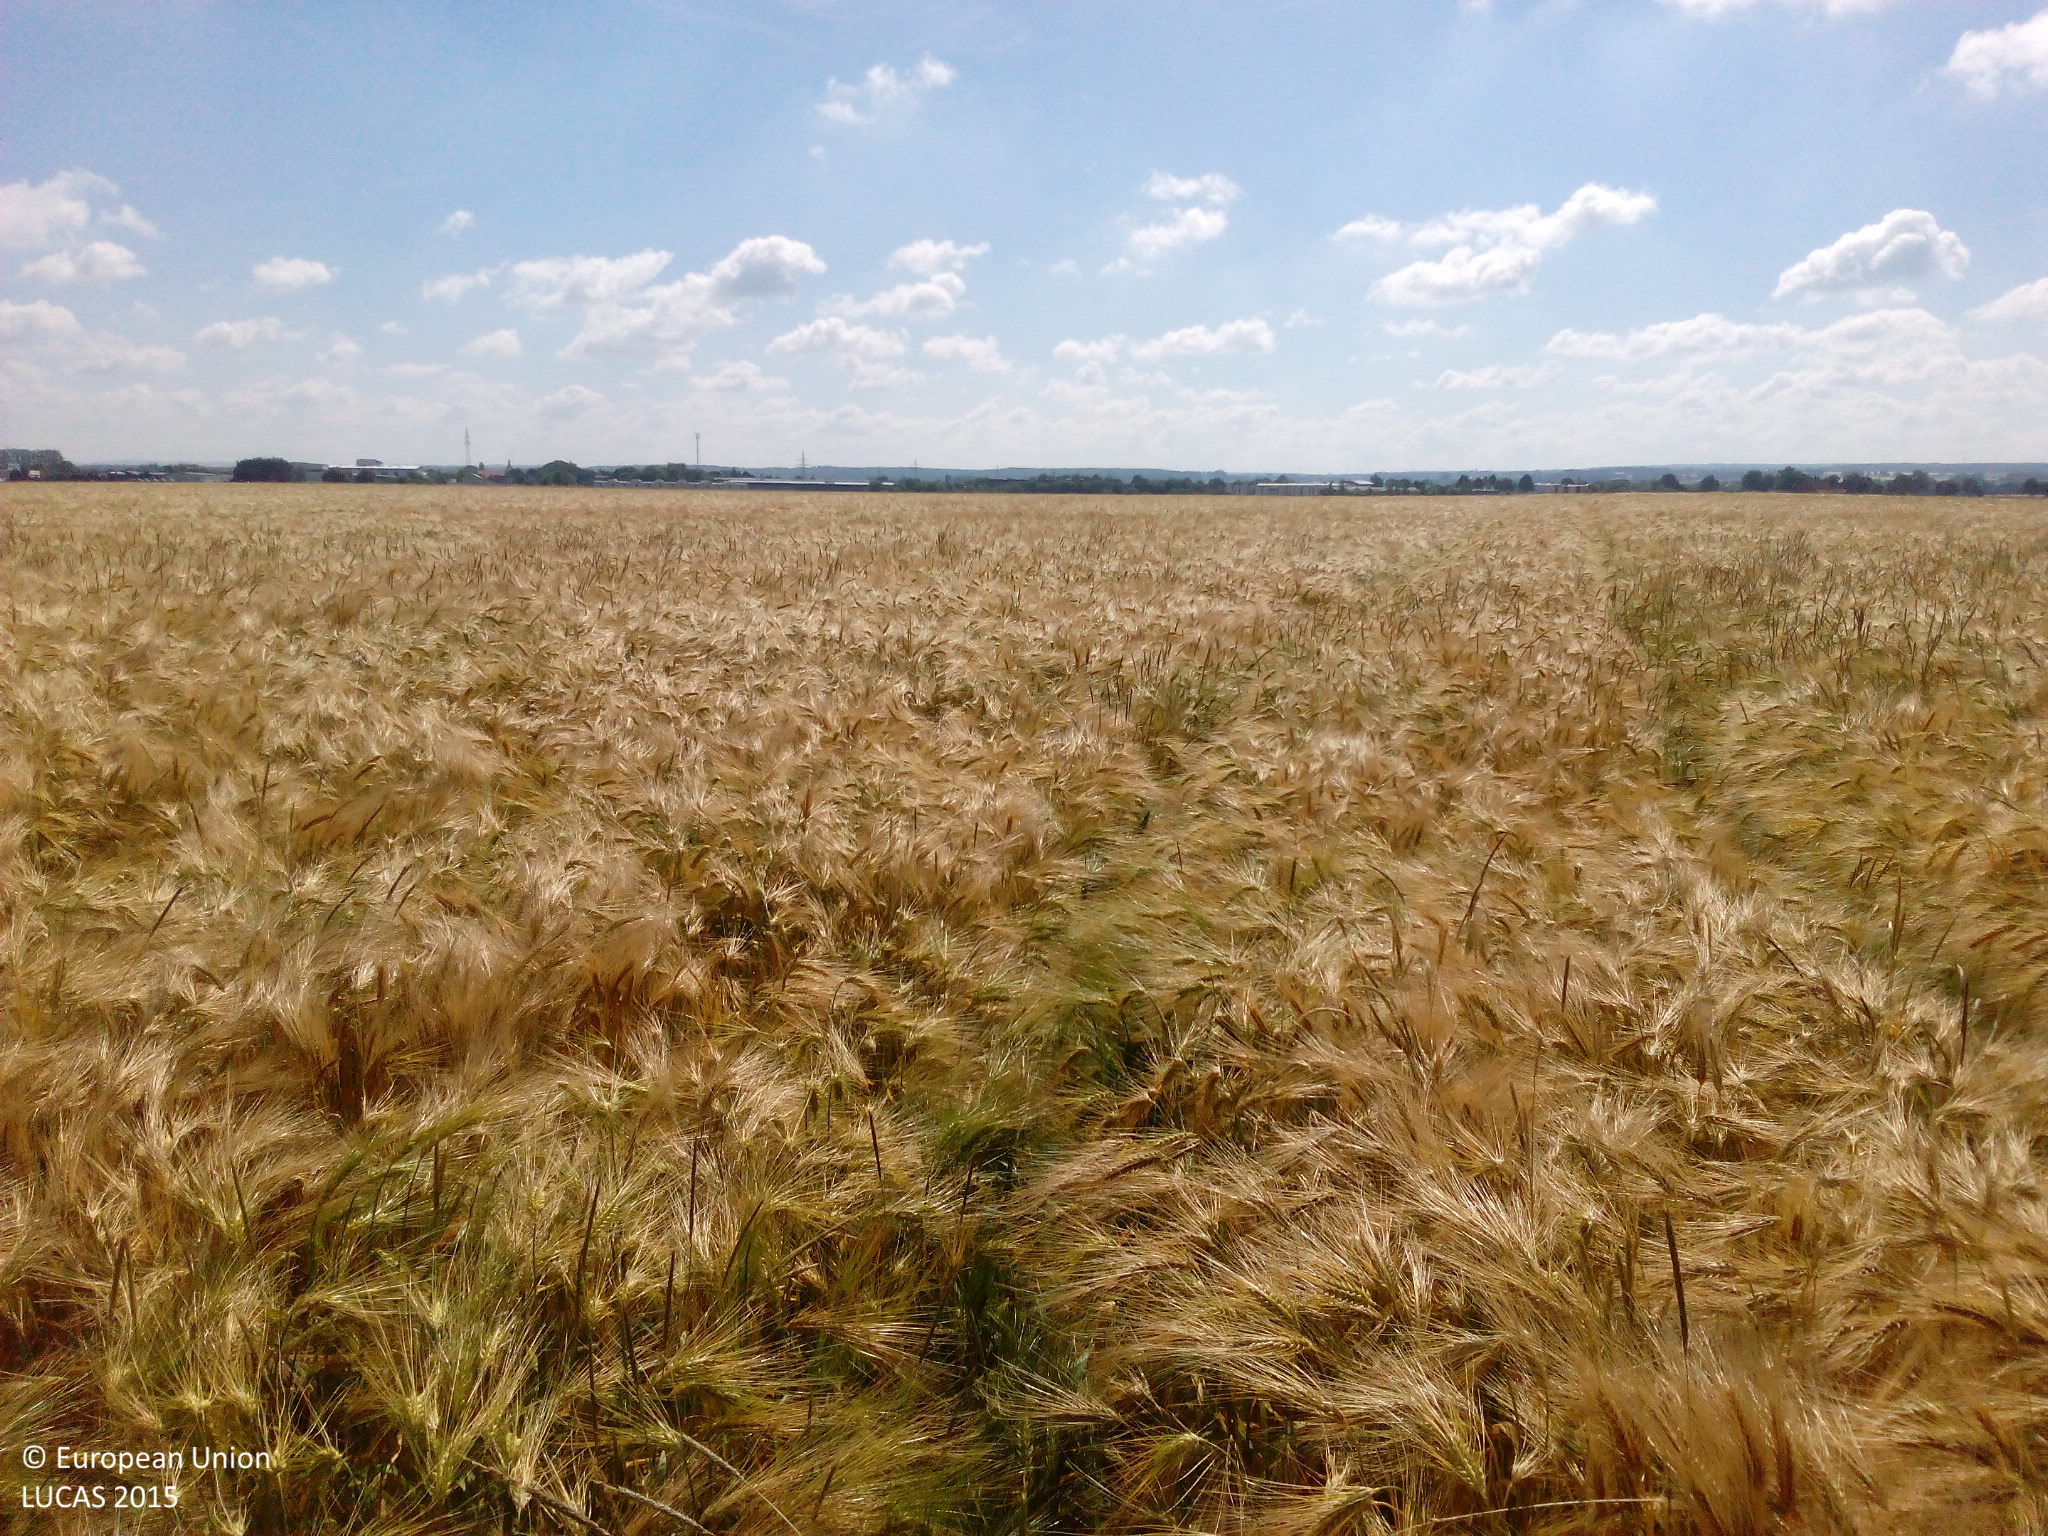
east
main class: Cropland
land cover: Barley
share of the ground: > 75 %
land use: Agriculture (excluding fallow land and kitchen gardens)
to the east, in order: Barley
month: June
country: DE
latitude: 51.6677
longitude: 8.5690
